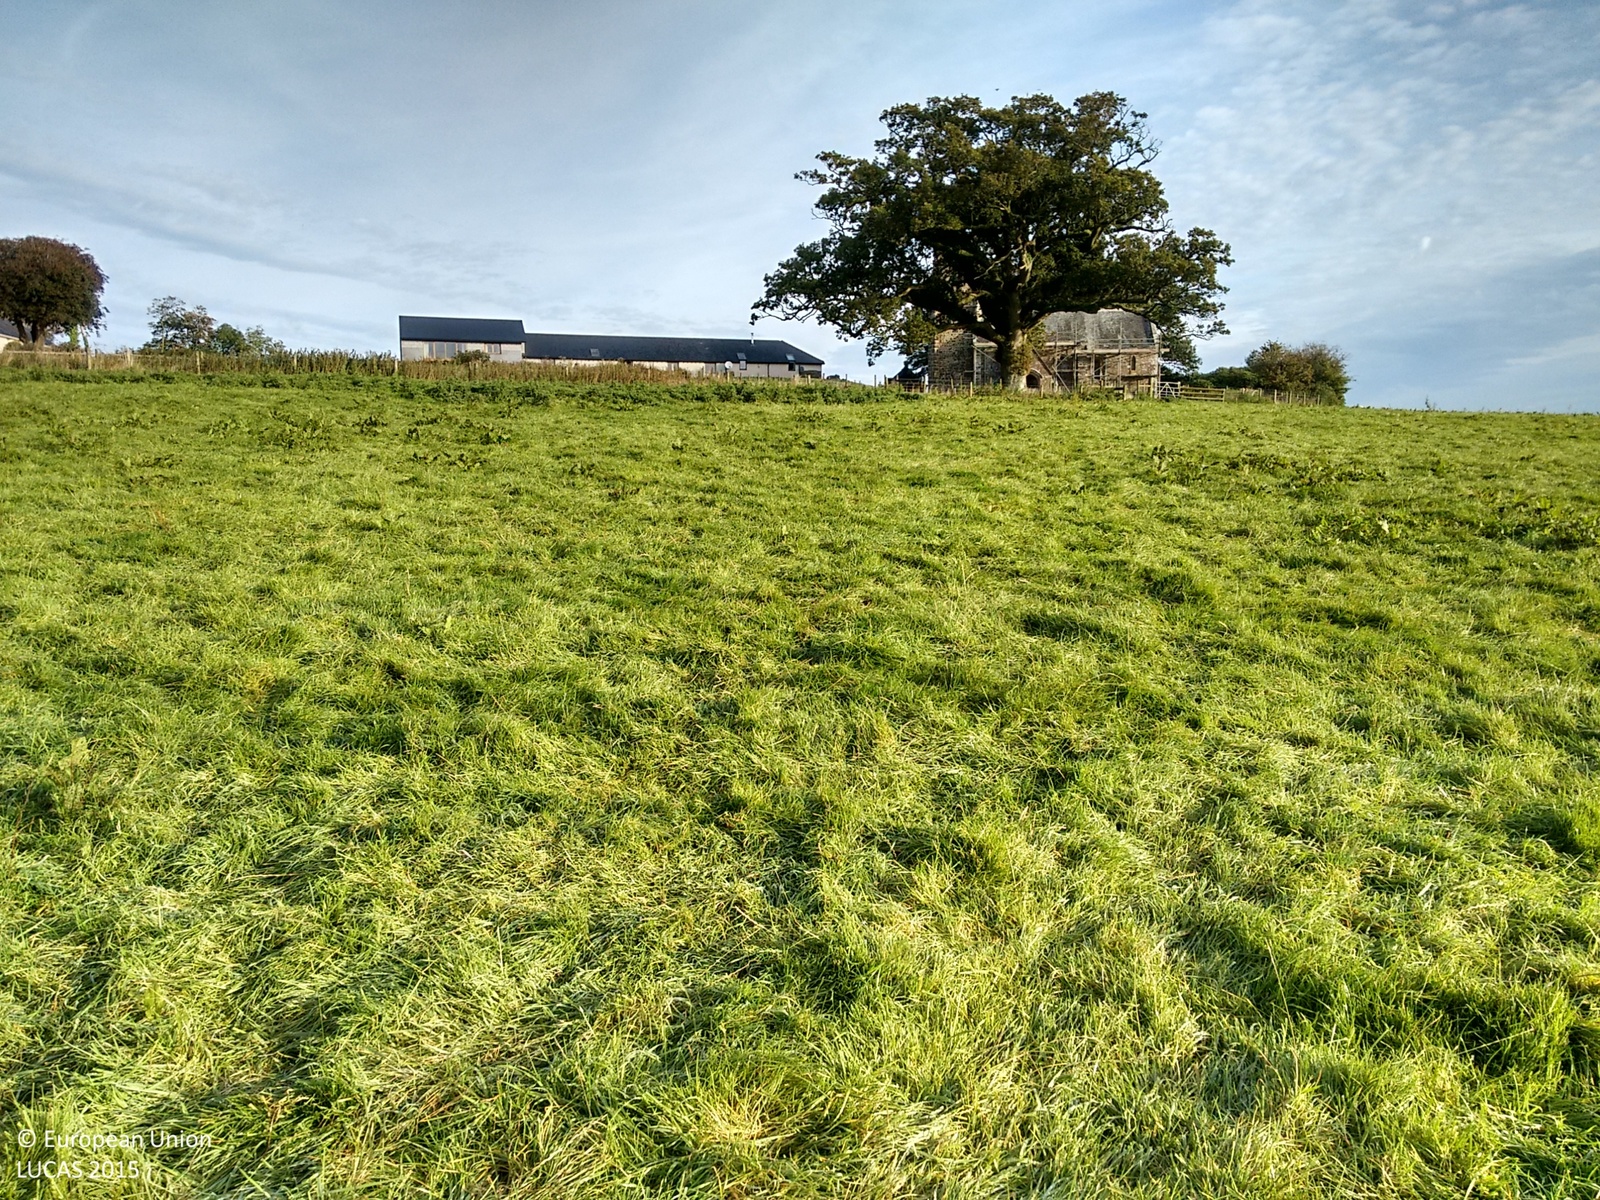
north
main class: Grassland
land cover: Grassland without tree/shrub cover
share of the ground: > 75 %
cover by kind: herbaceous plants 100 %
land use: Agriculture (excluding fallow land and kitchen gardens)
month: September
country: GB
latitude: 50.7610
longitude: -4.1173
